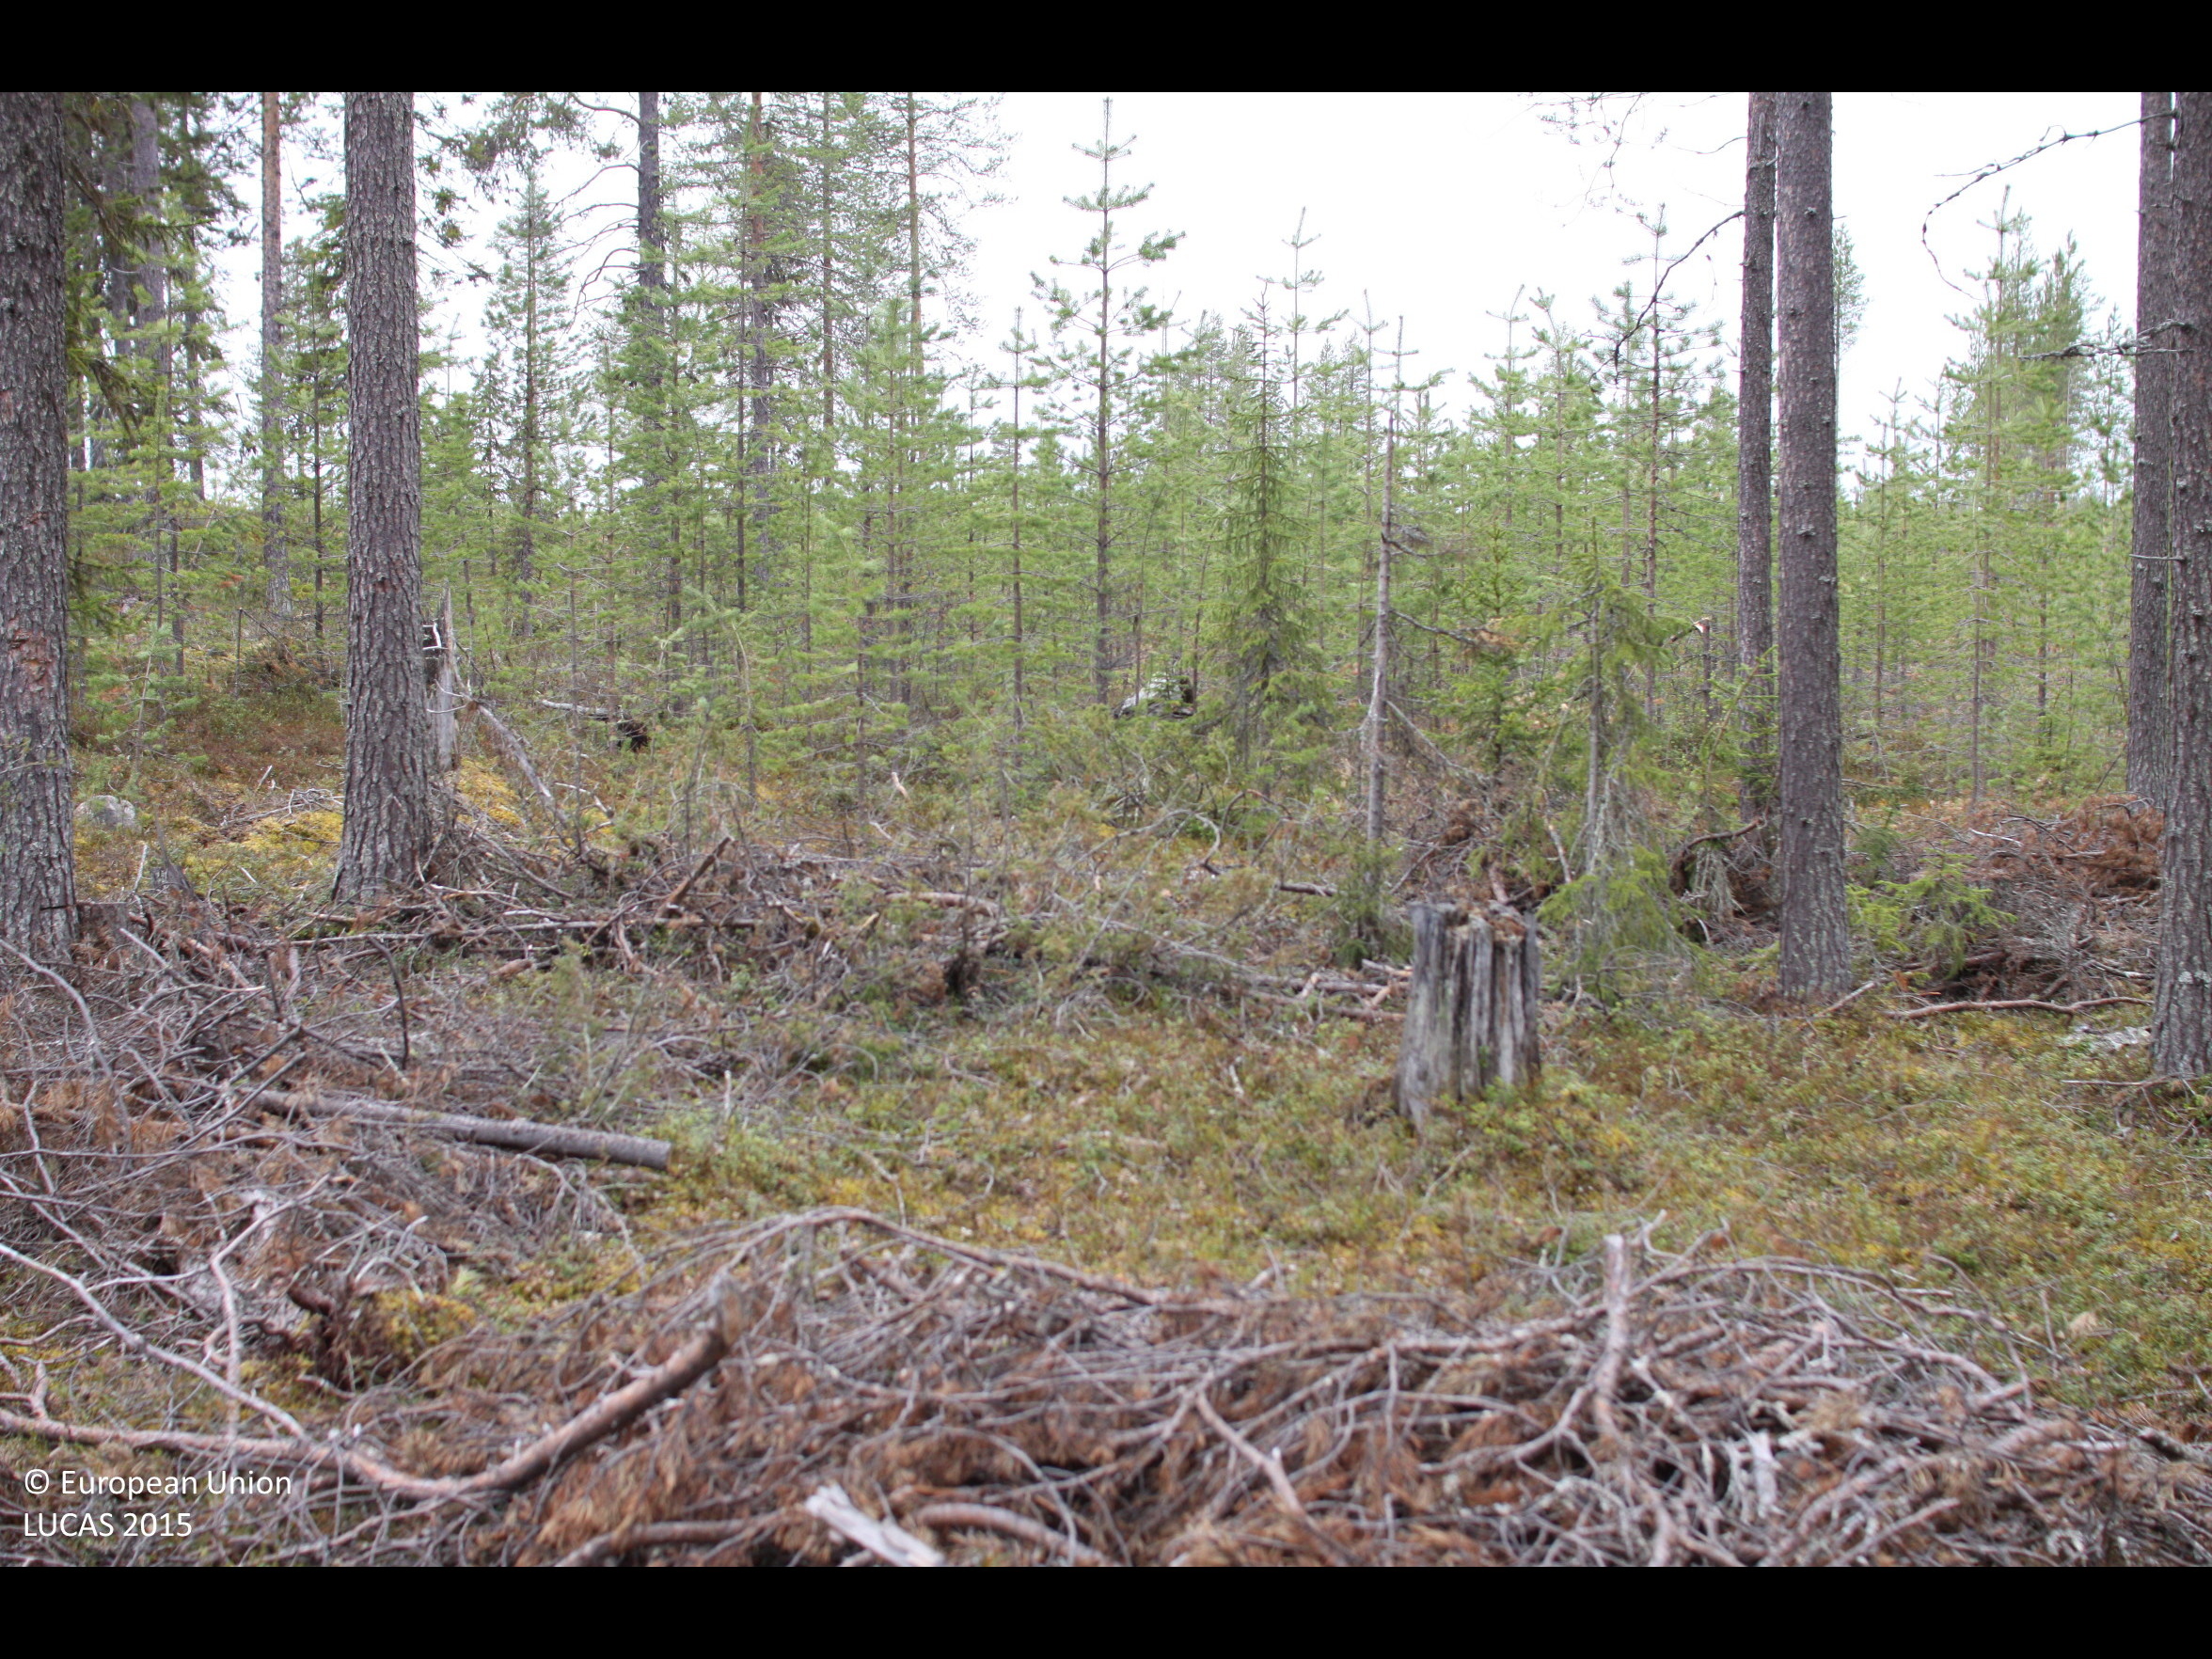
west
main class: Woodland
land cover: Pine dominated coniferous woodland
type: boreal forest
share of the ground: 25 - 50 %
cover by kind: shrubs 70 %, coniferous forest trees 30 %
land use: Forestry
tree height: > 5 m
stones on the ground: < 10 %
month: June
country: FI
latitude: 66.0906
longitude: 28.0709
